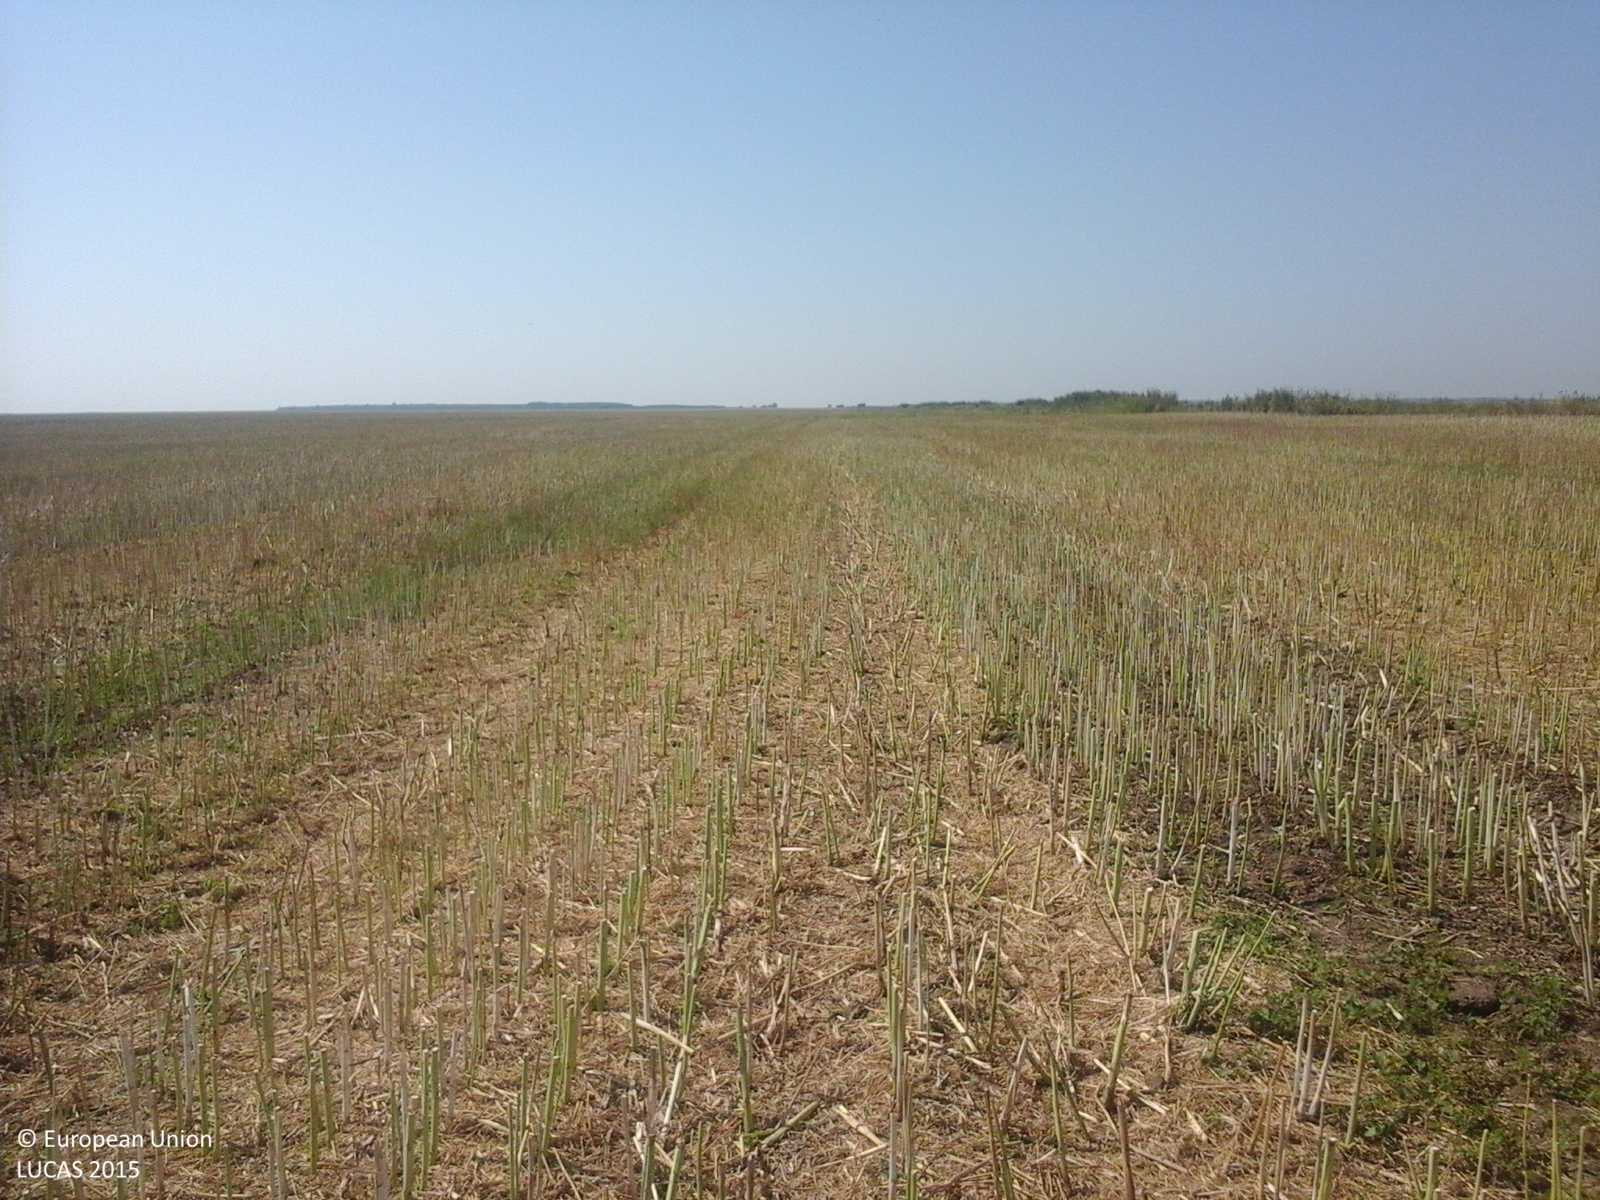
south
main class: Cropland
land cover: Rape and turnip rape
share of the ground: < 10 %
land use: Agriculture (excluding fallow land and kitchen gardens)
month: July
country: RO
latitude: 44.0778
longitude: 24.7444
